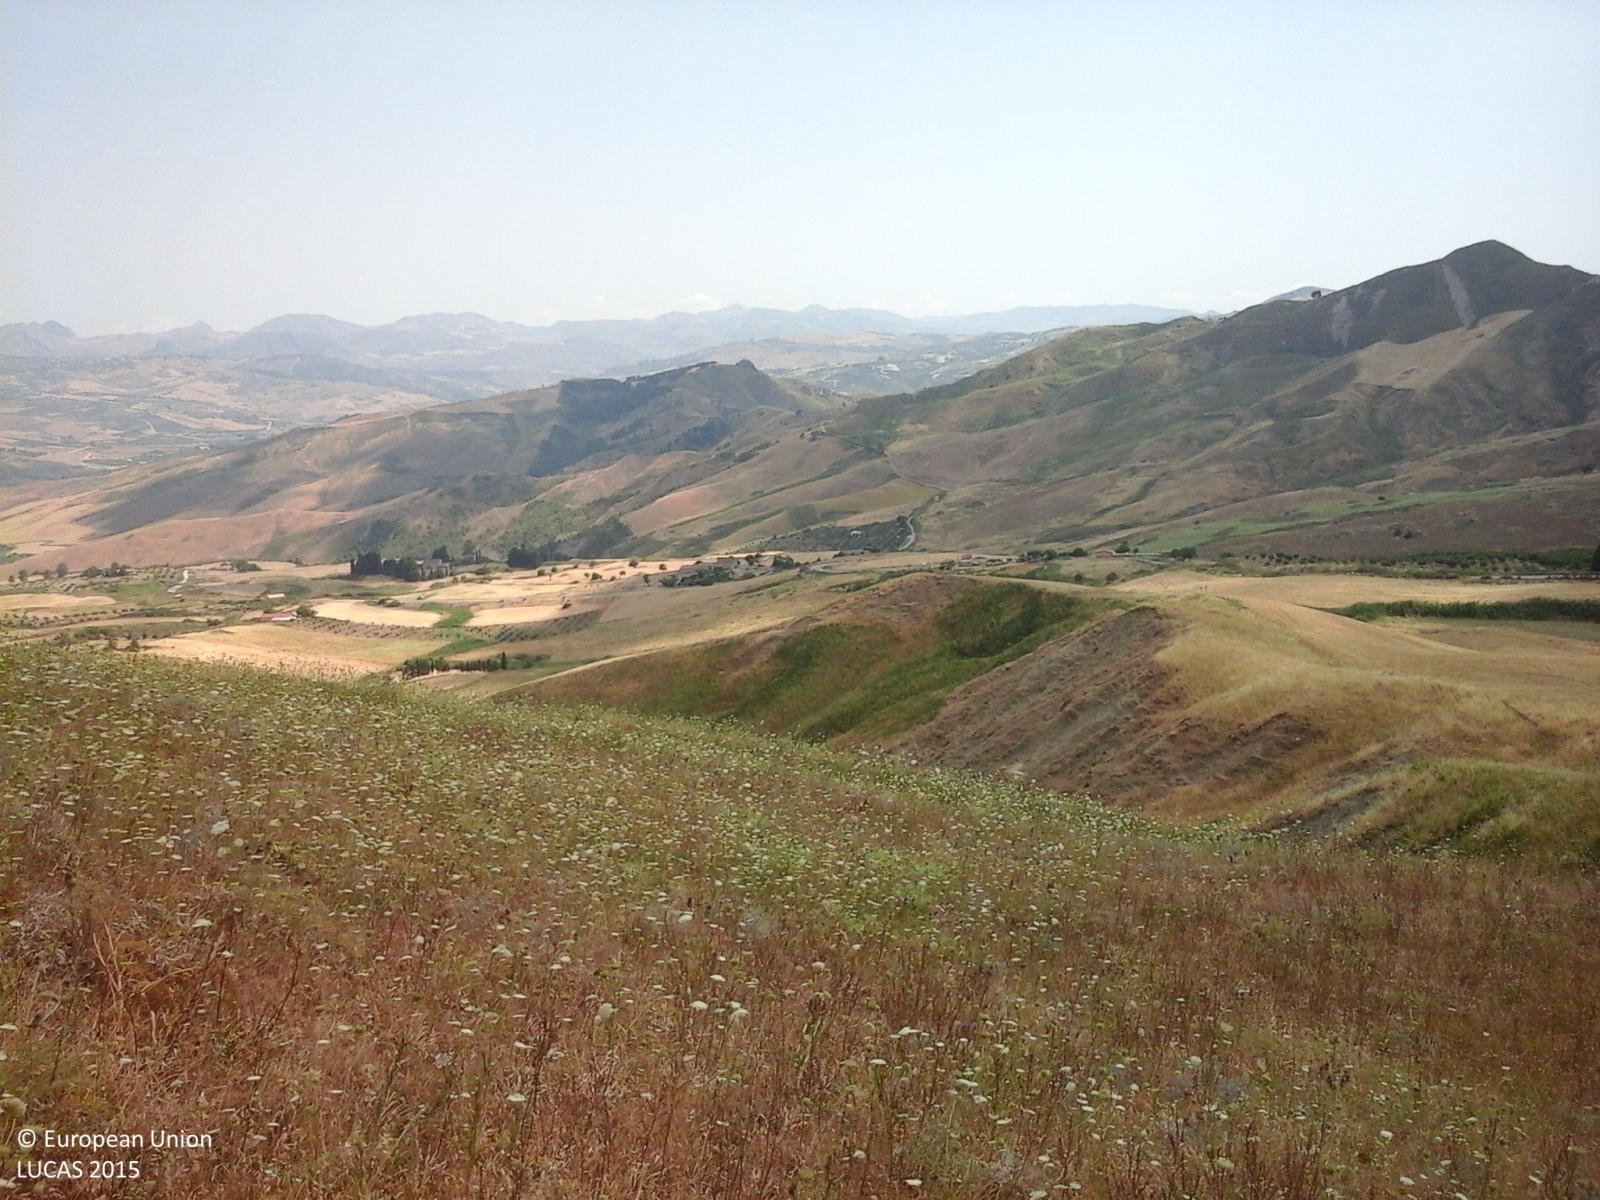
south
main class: Grassland
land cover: Grassland without tree/shrub cover
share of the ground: > 75 %
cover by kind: herbaceous plants 100 %
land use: Abandoned areas
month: July
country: IT
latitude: 37.5916
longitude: 13.5184
